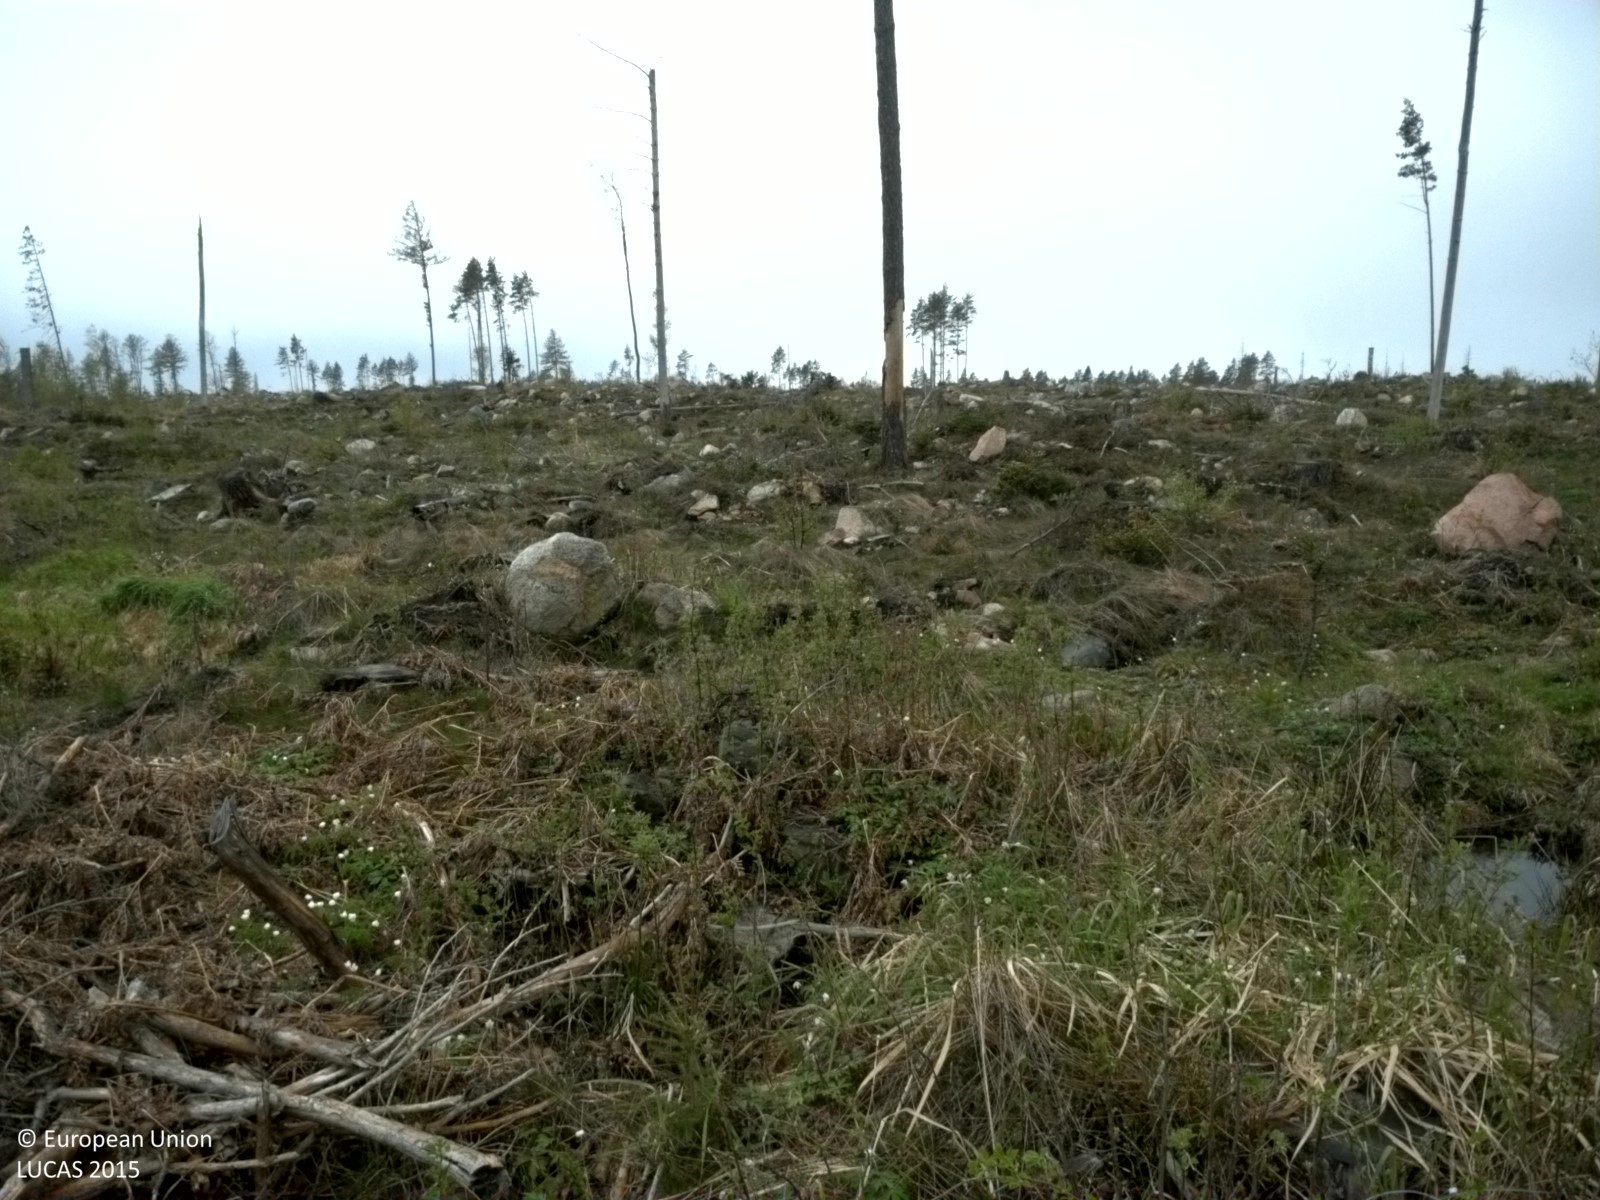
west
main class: Grassland
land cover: Grassland with sparse tree/shrub cover
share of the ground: 50 - 75 %
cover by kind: herbaceous plants 60 %, shrubs 10 %, coniferous forest trees 5 %
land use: Forestry
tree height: > 5 m
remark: Clear cut
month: May
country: SE
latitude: 60.1718
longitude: 17.9788
